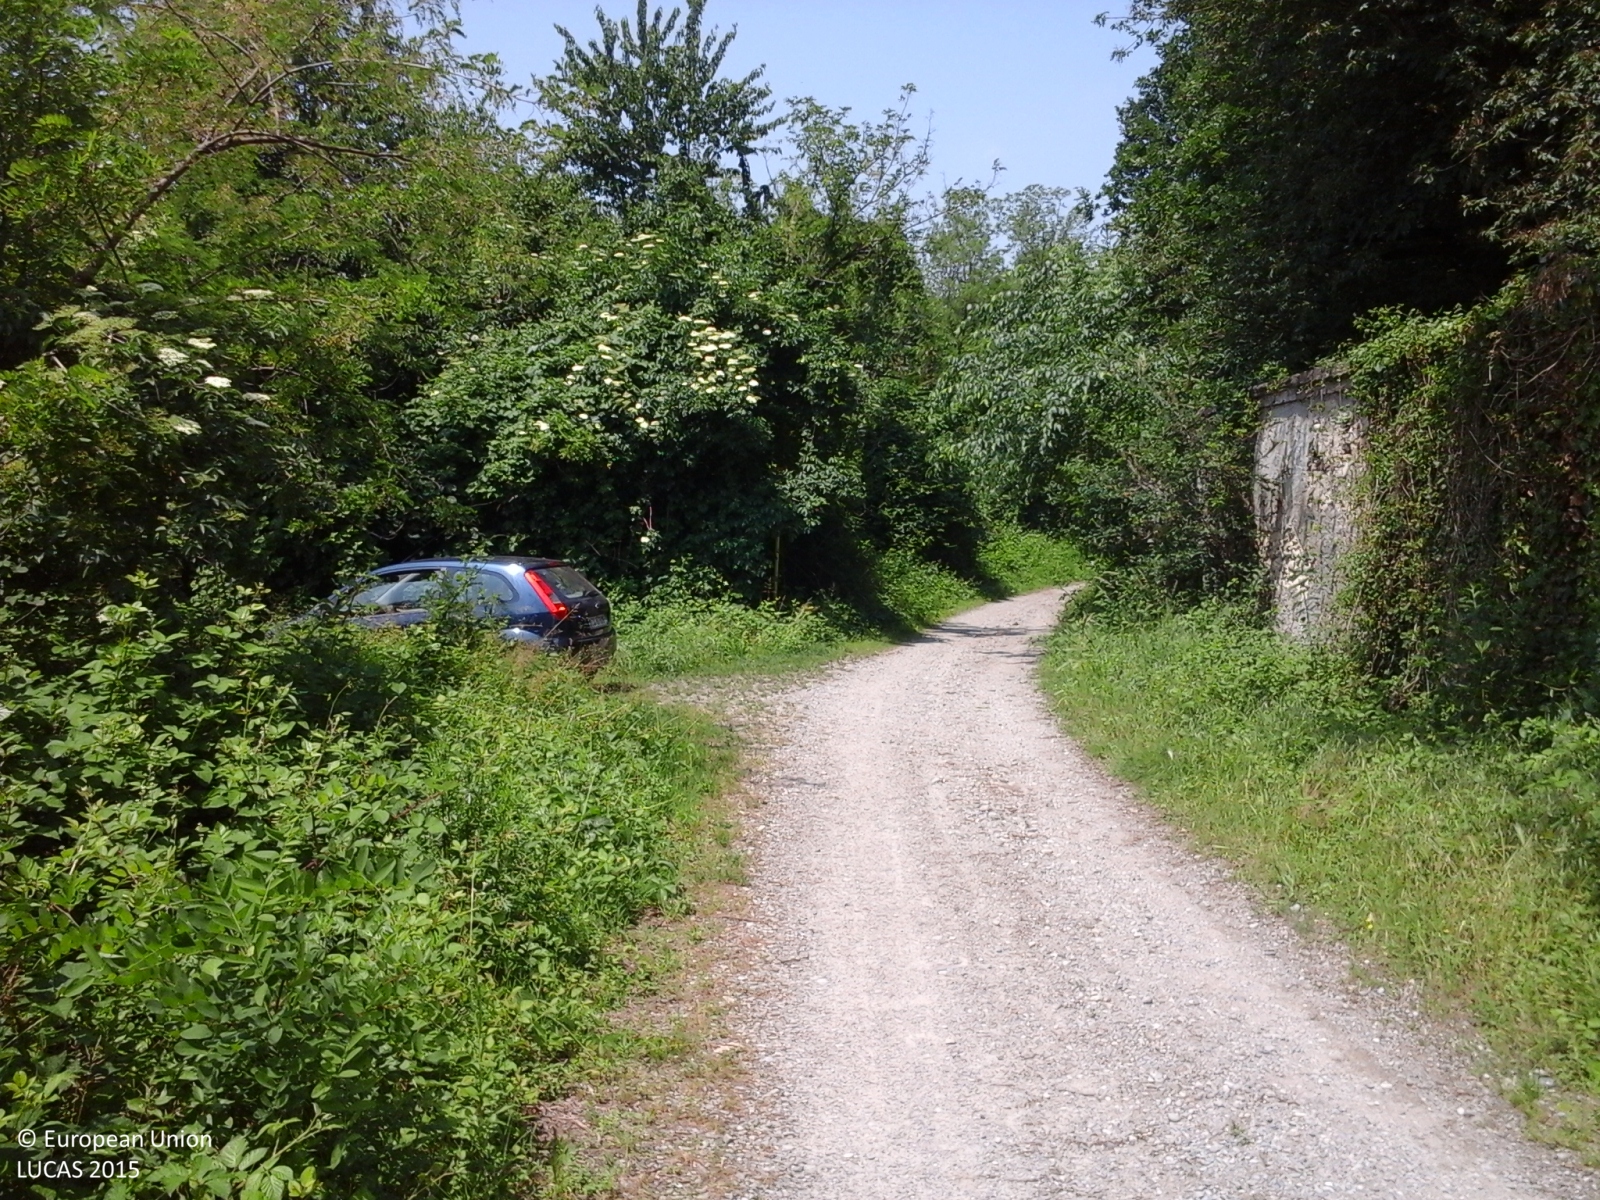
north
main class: Woodland
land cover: Broadleaved woodland
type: thermophilous deciduous forest
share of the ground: > 75 %
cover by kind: broadleaved forest trees 100 %
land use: Amenities, museums, leisure
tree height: > 5 m
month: May
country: IT
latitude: 45.5934
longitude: 9.5265
